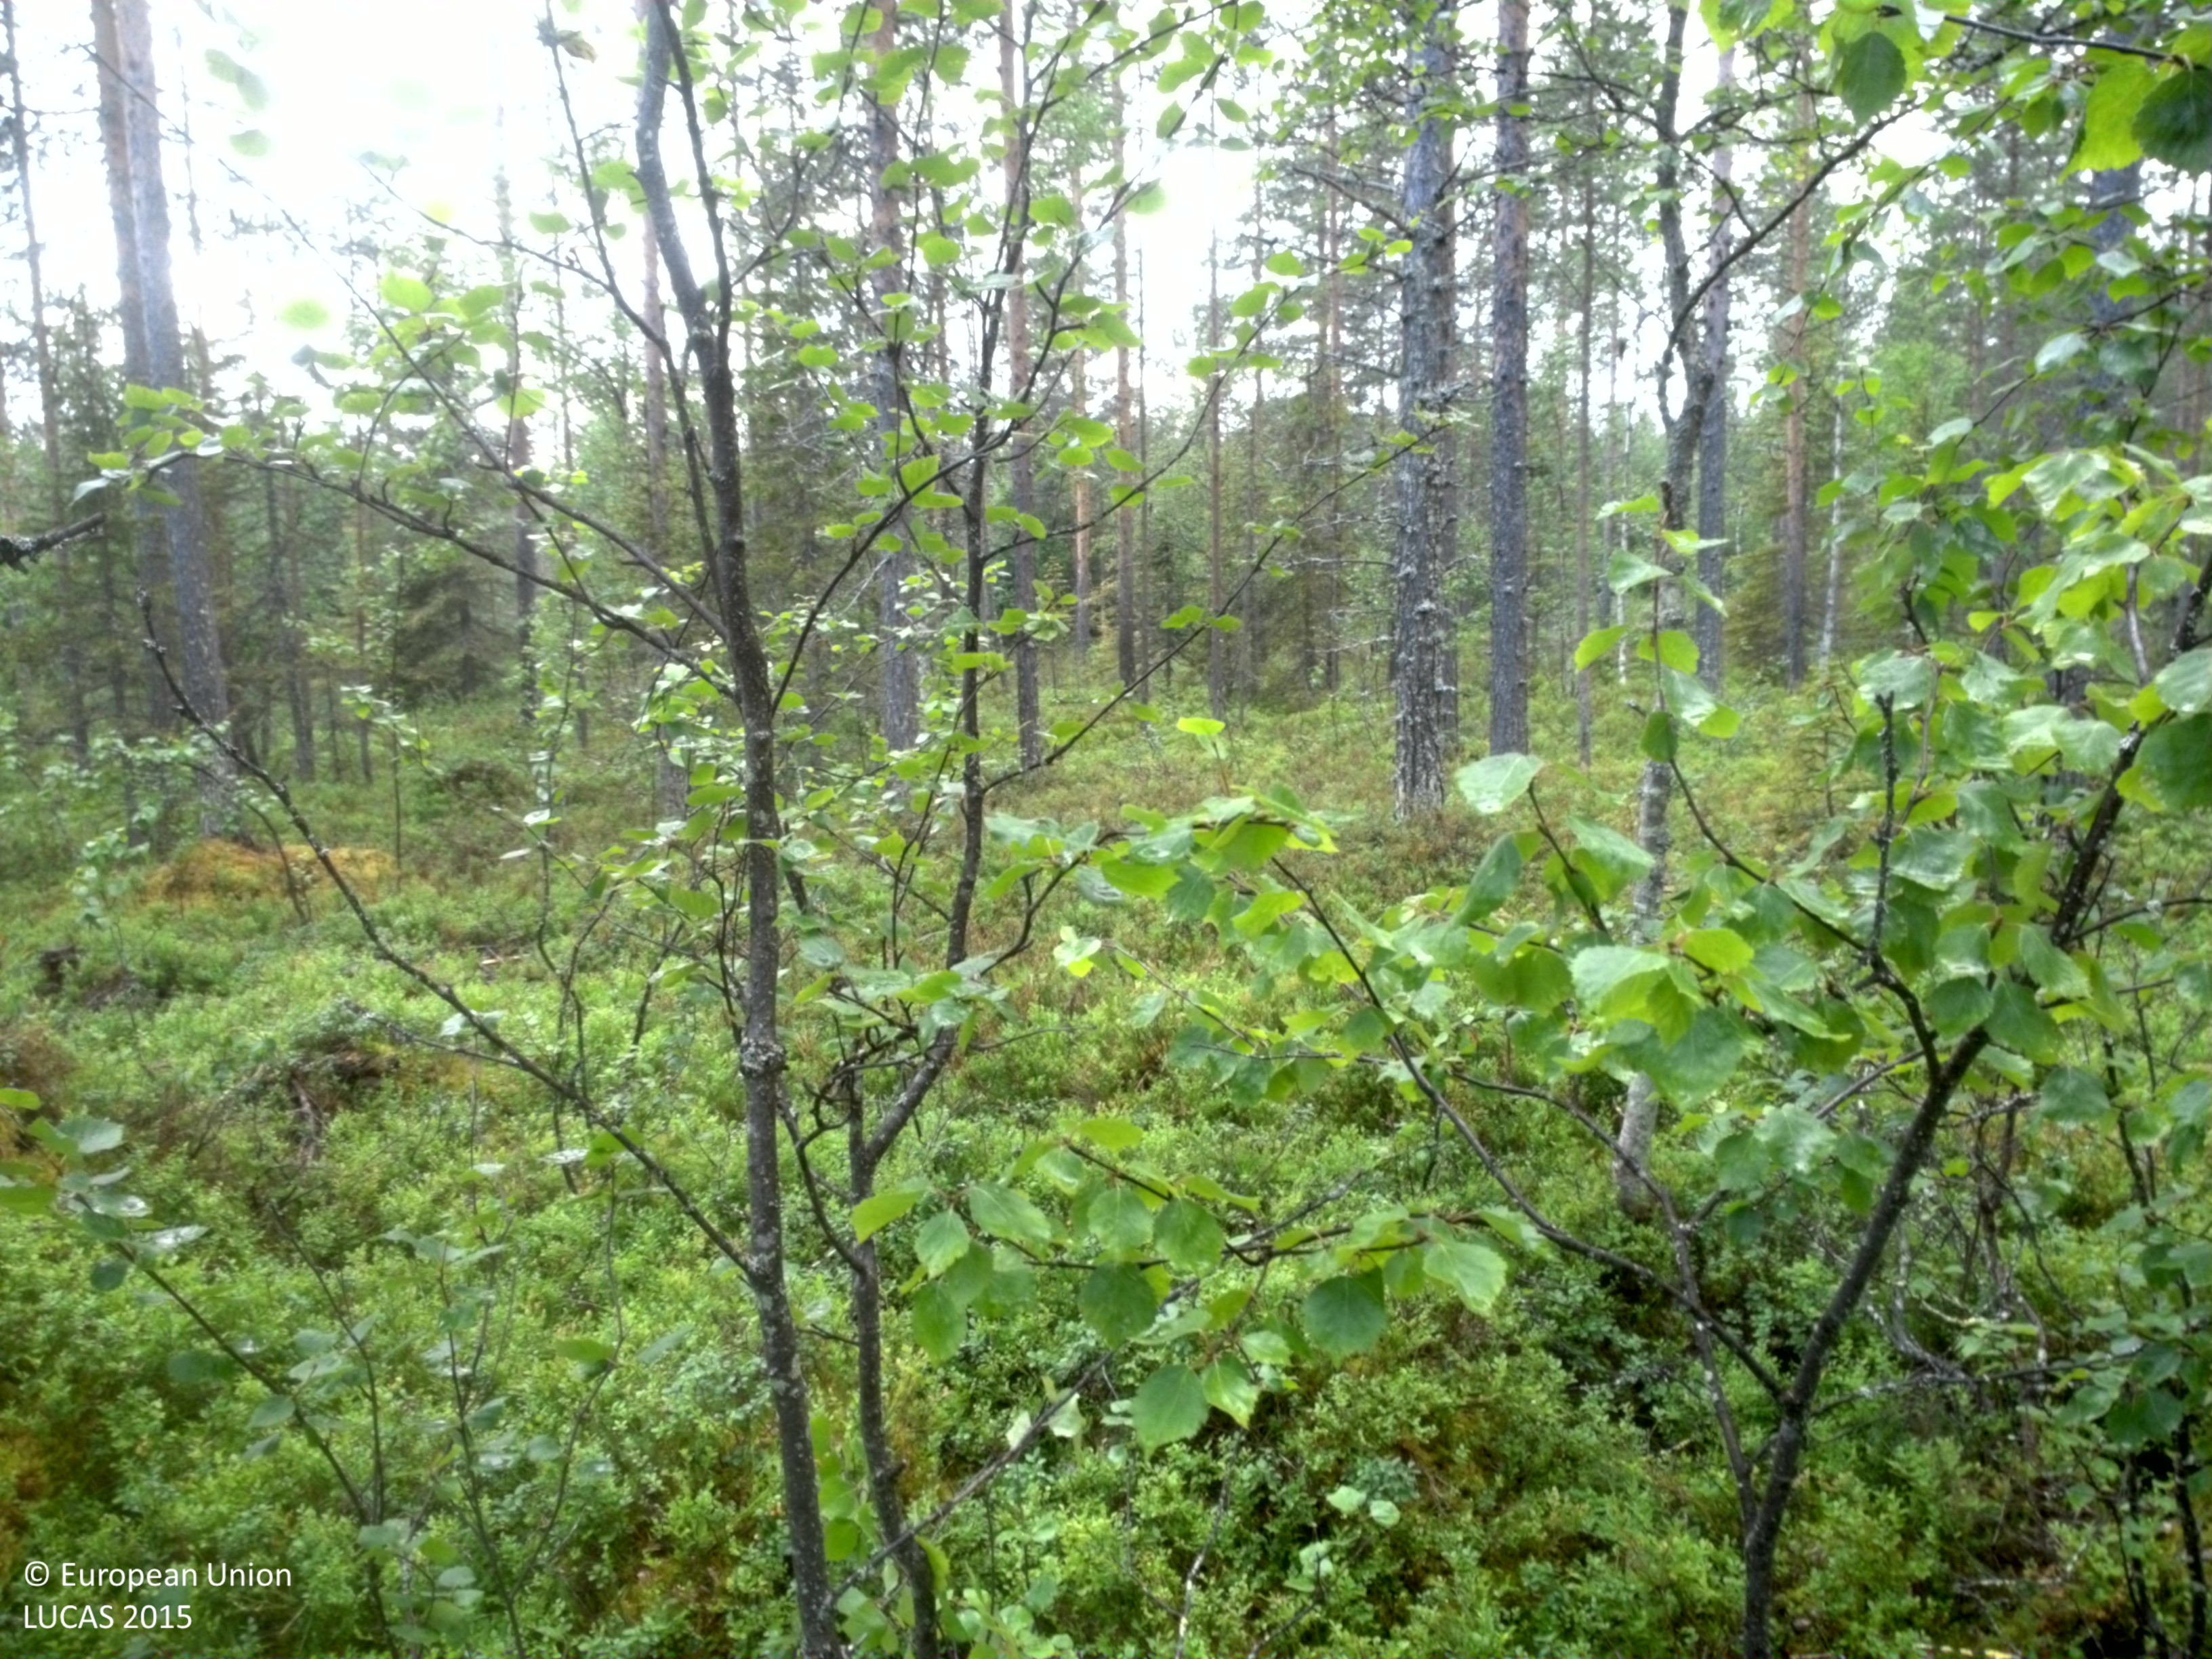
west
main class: Woodland
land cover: Pine dominated coniferous woodland
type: boreal forest
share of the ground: 25 - 50 %
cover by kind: shrubs 60 %, coniferous forest trees 30 %, broadleaved forest trees 5 %, lichens and mosses 5 %
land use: Forestry
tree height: > 5 m
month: July
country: SE
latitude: 66.1532
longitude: 20.4444
